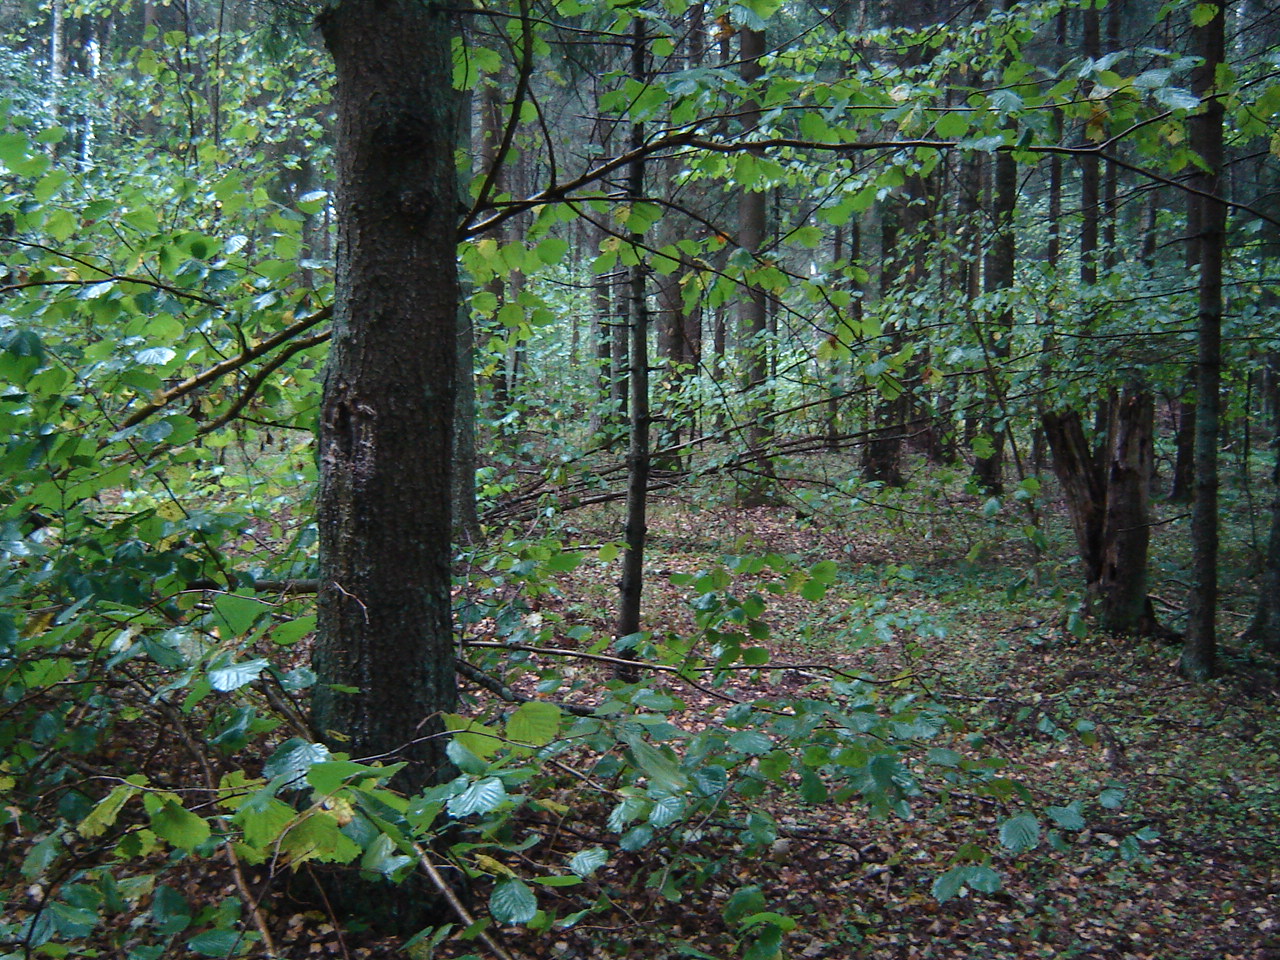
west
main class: Woodland
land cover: Spruce dominated mixed woodland
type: hemiboreal forest and nemoral coniferous forest and mixed broadleaved-coniferous forest
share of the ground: > 75 %
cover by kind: coniferous forest trees 60 %, broadleaved forest trees 30 %, herbaceous plants 5 %, unconsolidated bare surface 5 %
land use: Forestry
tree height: > 5 m
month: September
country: LT
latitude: 54.4448
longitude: 25.0905
